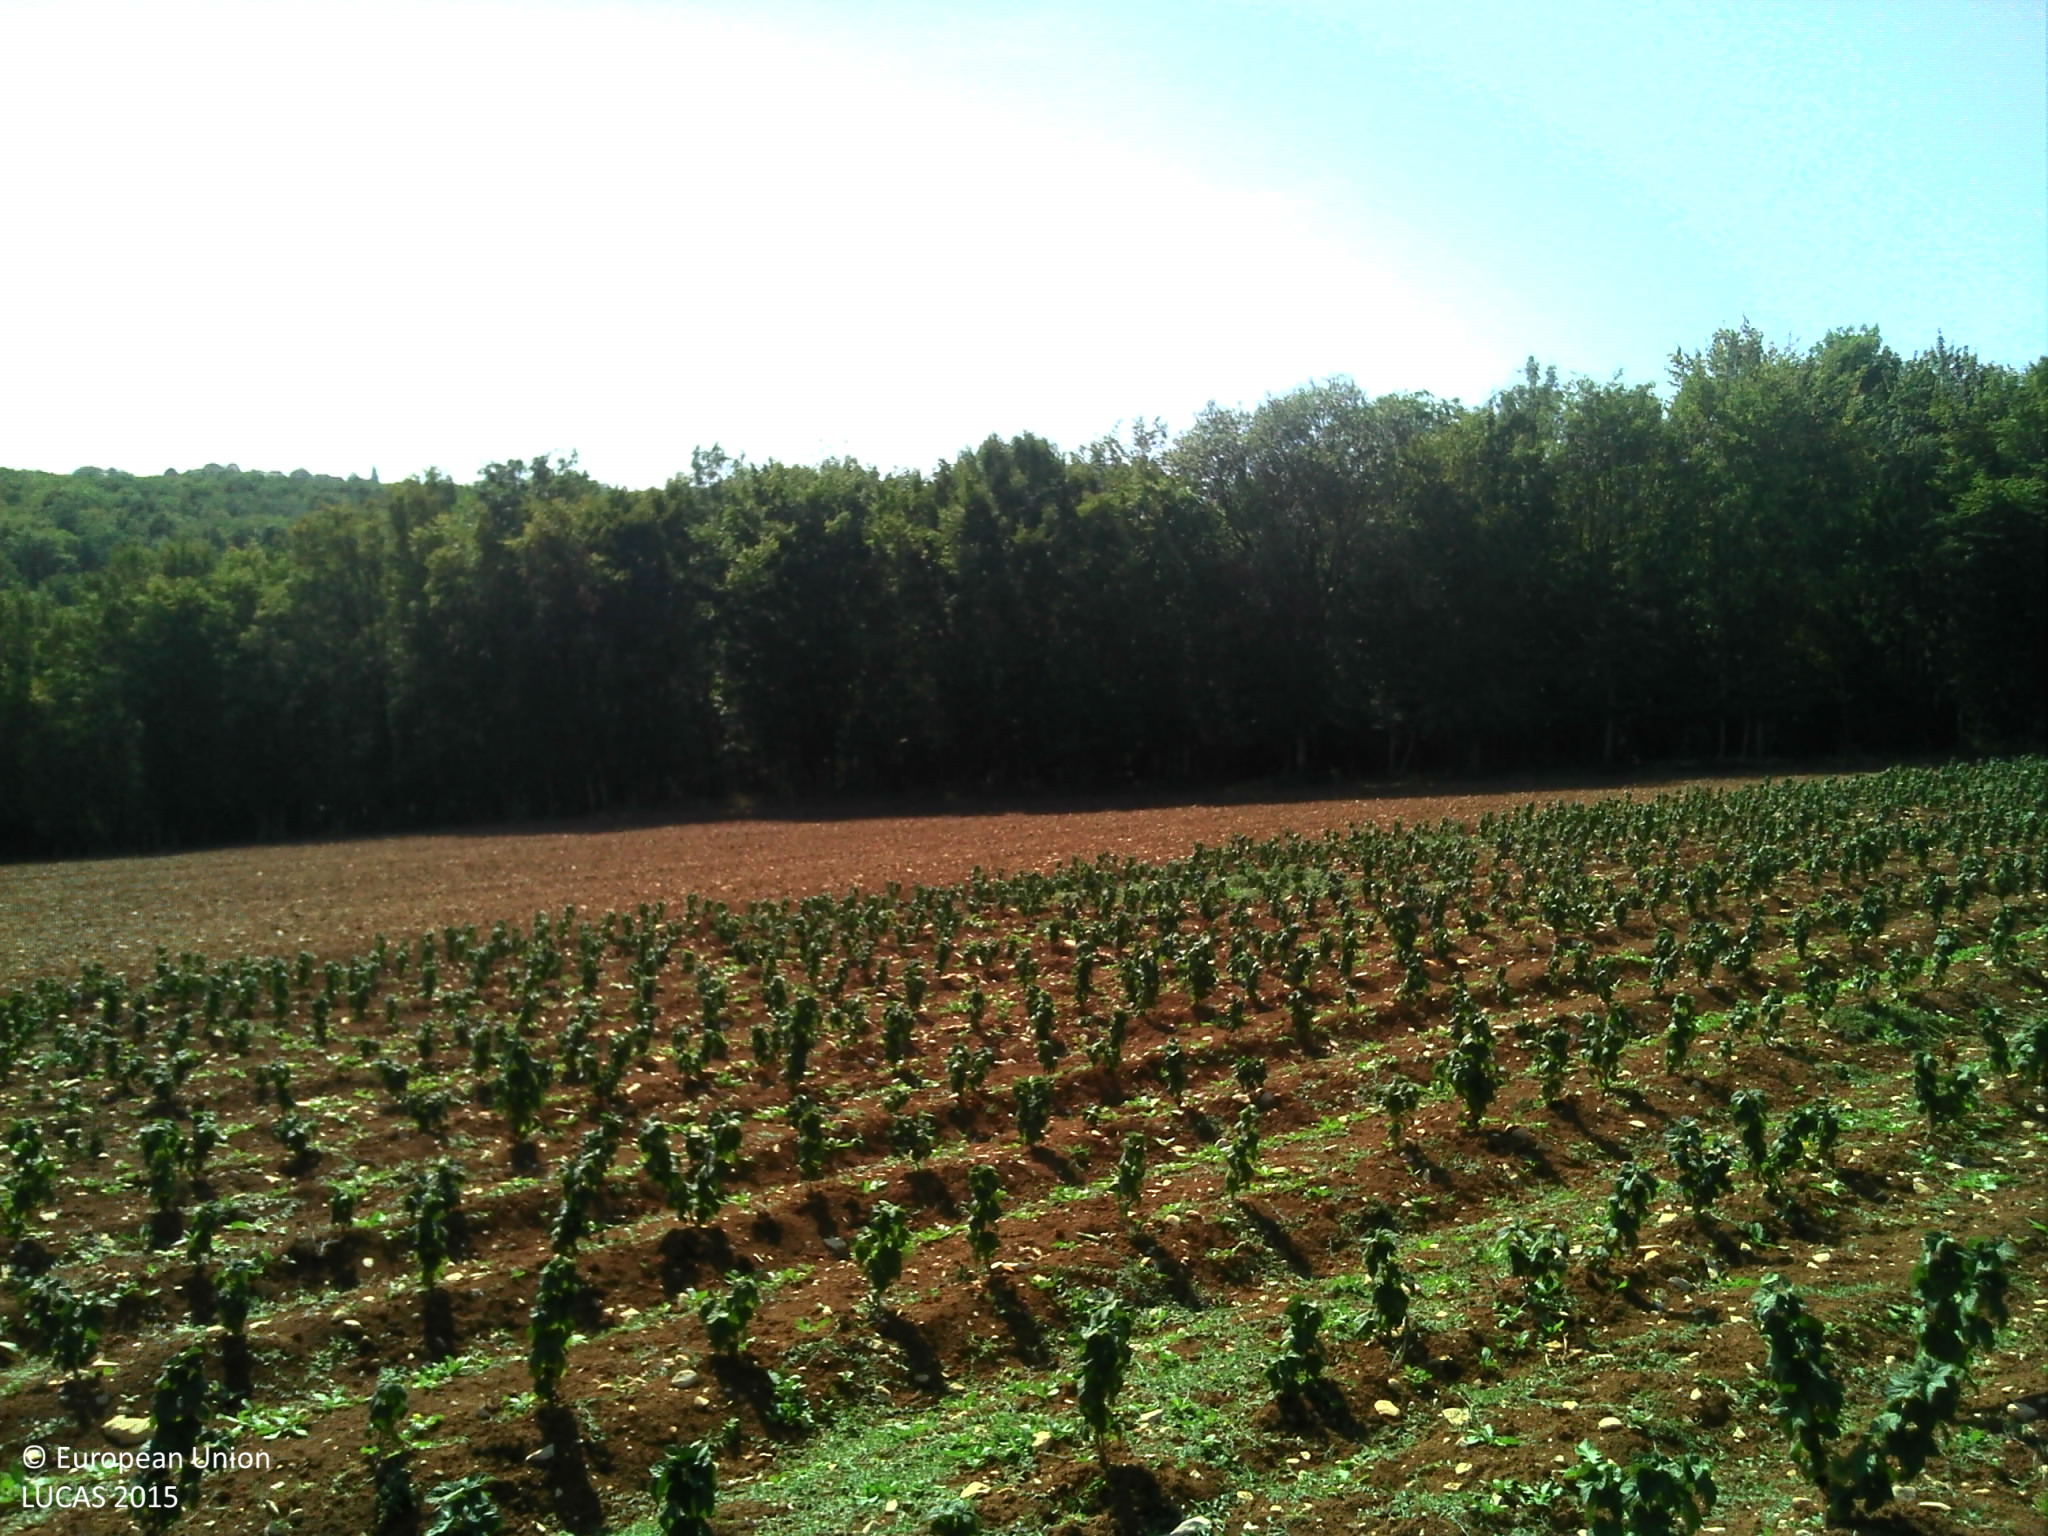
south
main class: Cropland
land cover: Other non-permanent industrial crops
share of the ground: 10 - 25 %
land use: Agriculture (excluding fallow land and kitchen gardens)
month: August
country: FR
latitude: 47.2536
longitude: 4.8073
